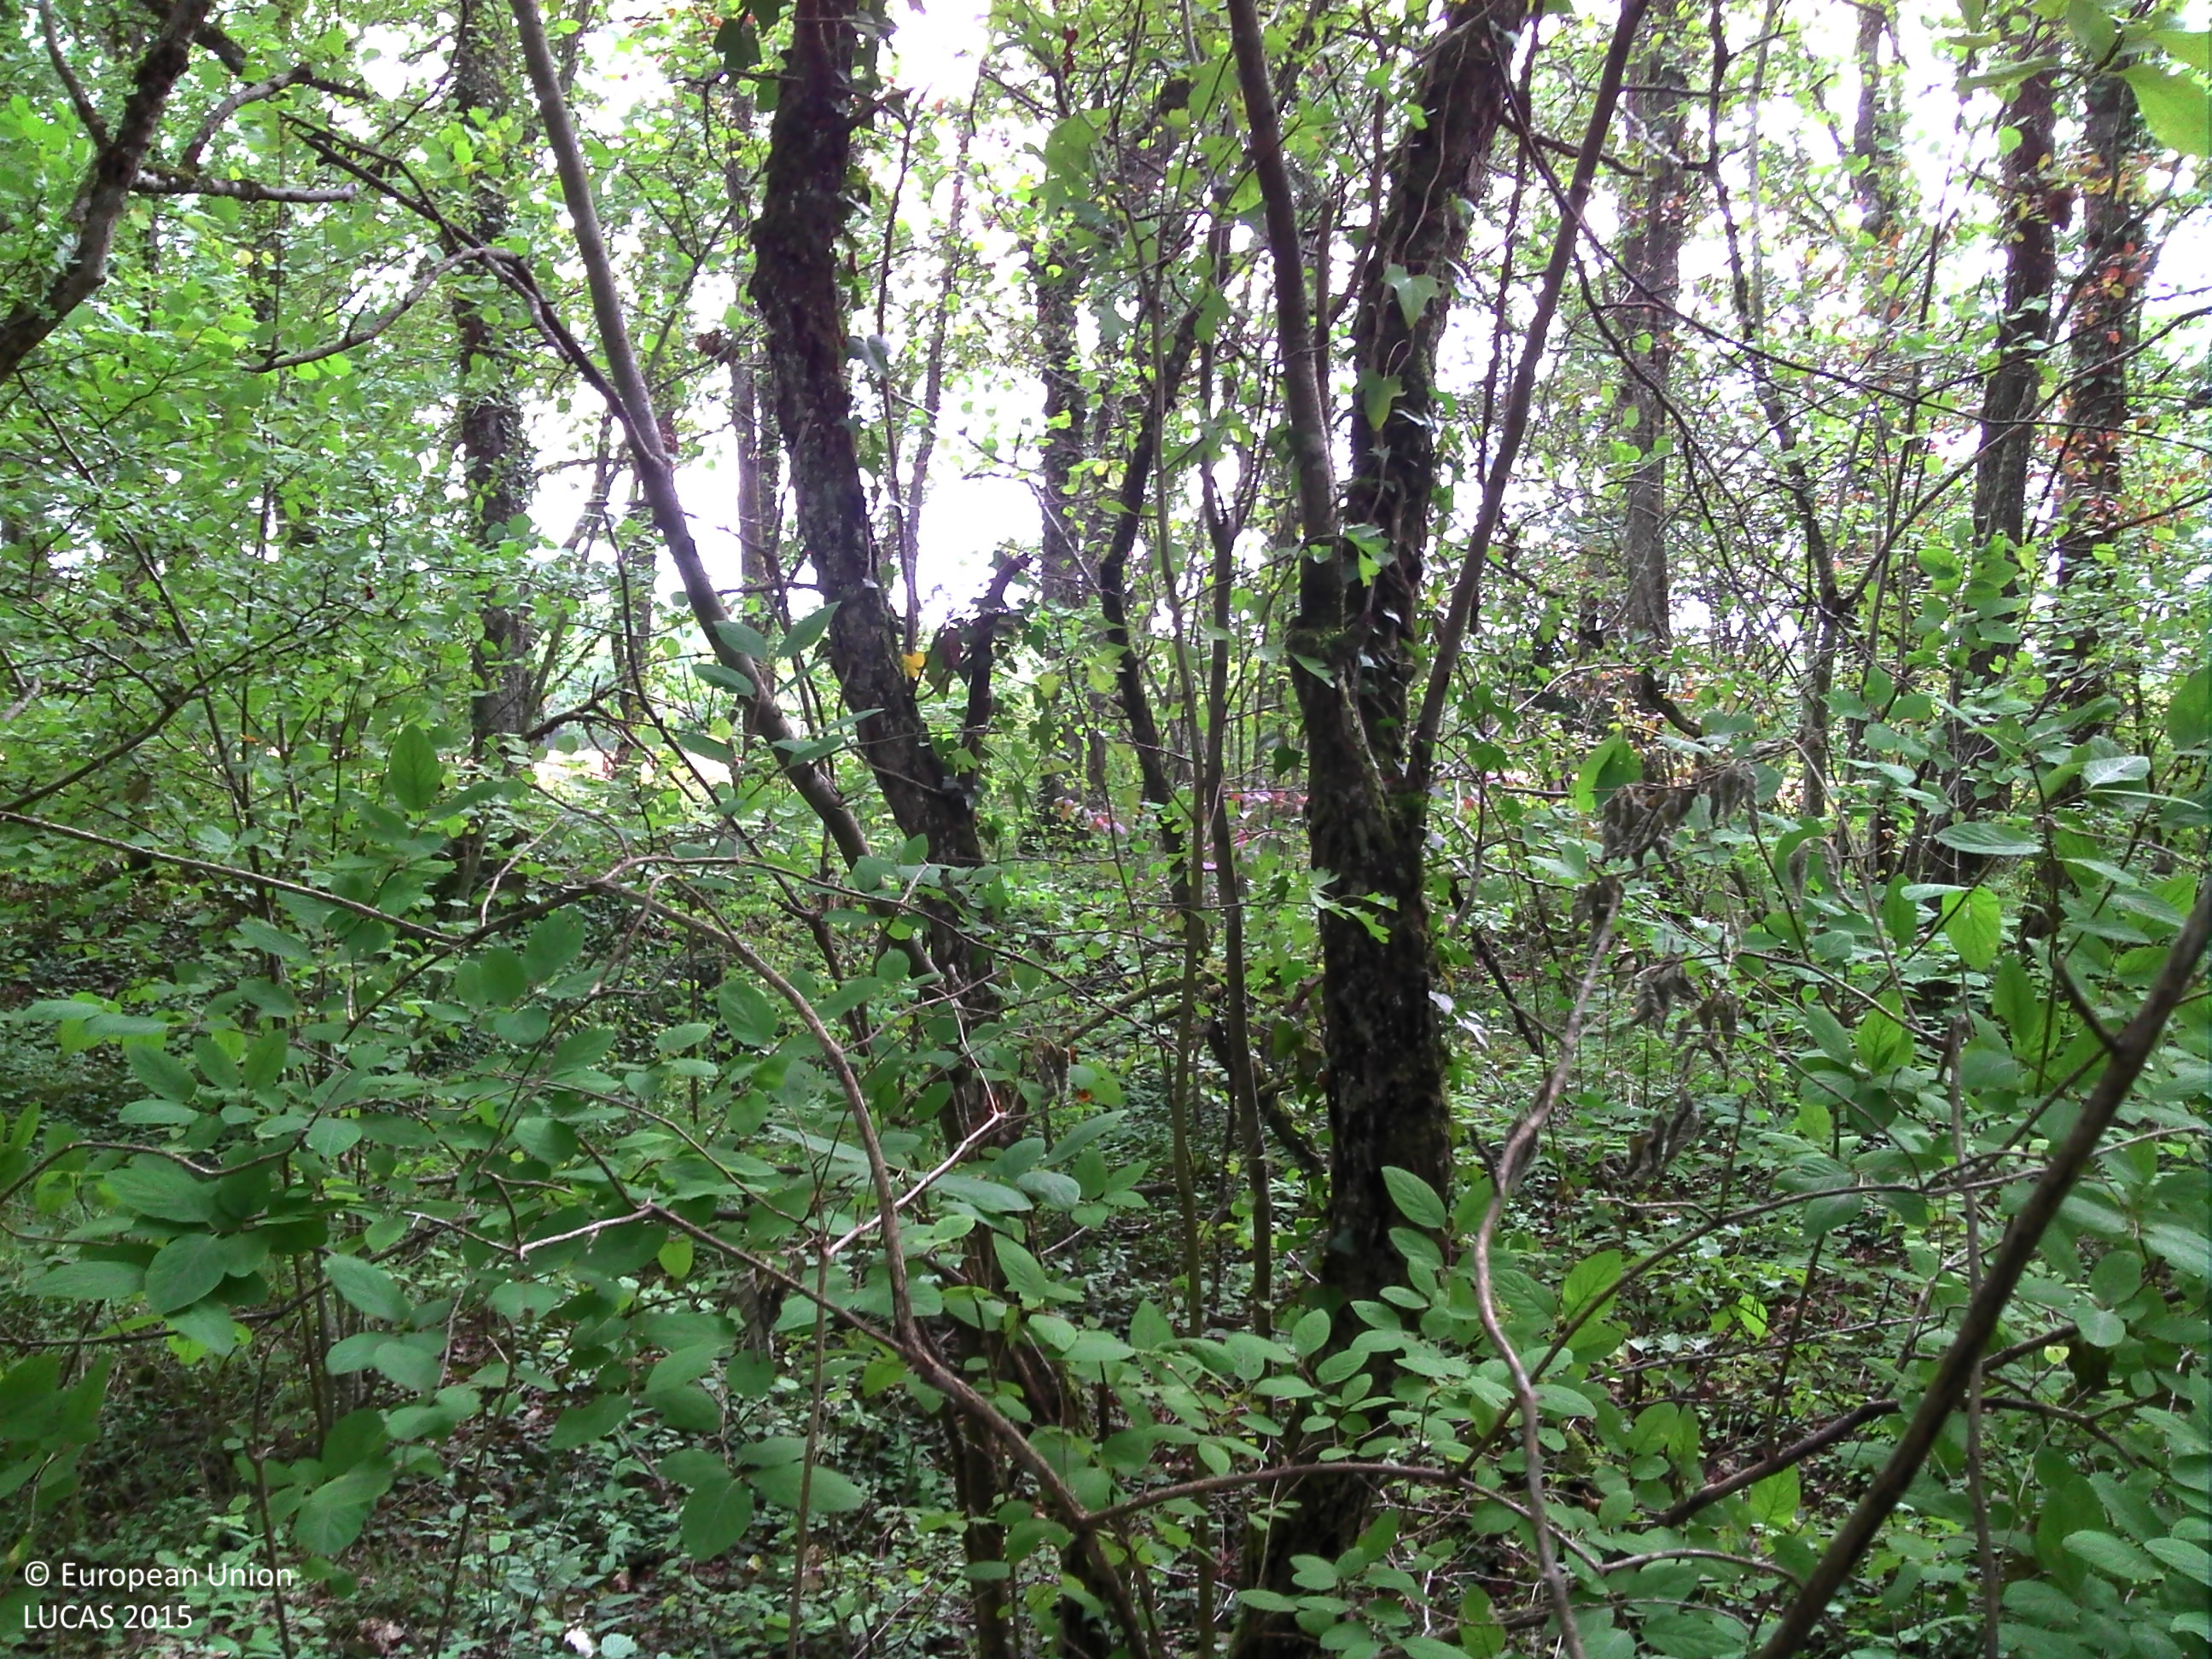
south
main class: Woodland
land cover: Broadleaved woodland
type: mesophytic deciduous forest
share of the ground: > 75 %
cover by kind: broadleaved forest trees 80 %, herbaceous plants 10 %, shrubs 5 %, lichens and mosses 5 %
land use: Forestry
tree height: > 5 m
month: September
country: FR
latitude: 48.2201
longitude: 4.6545
